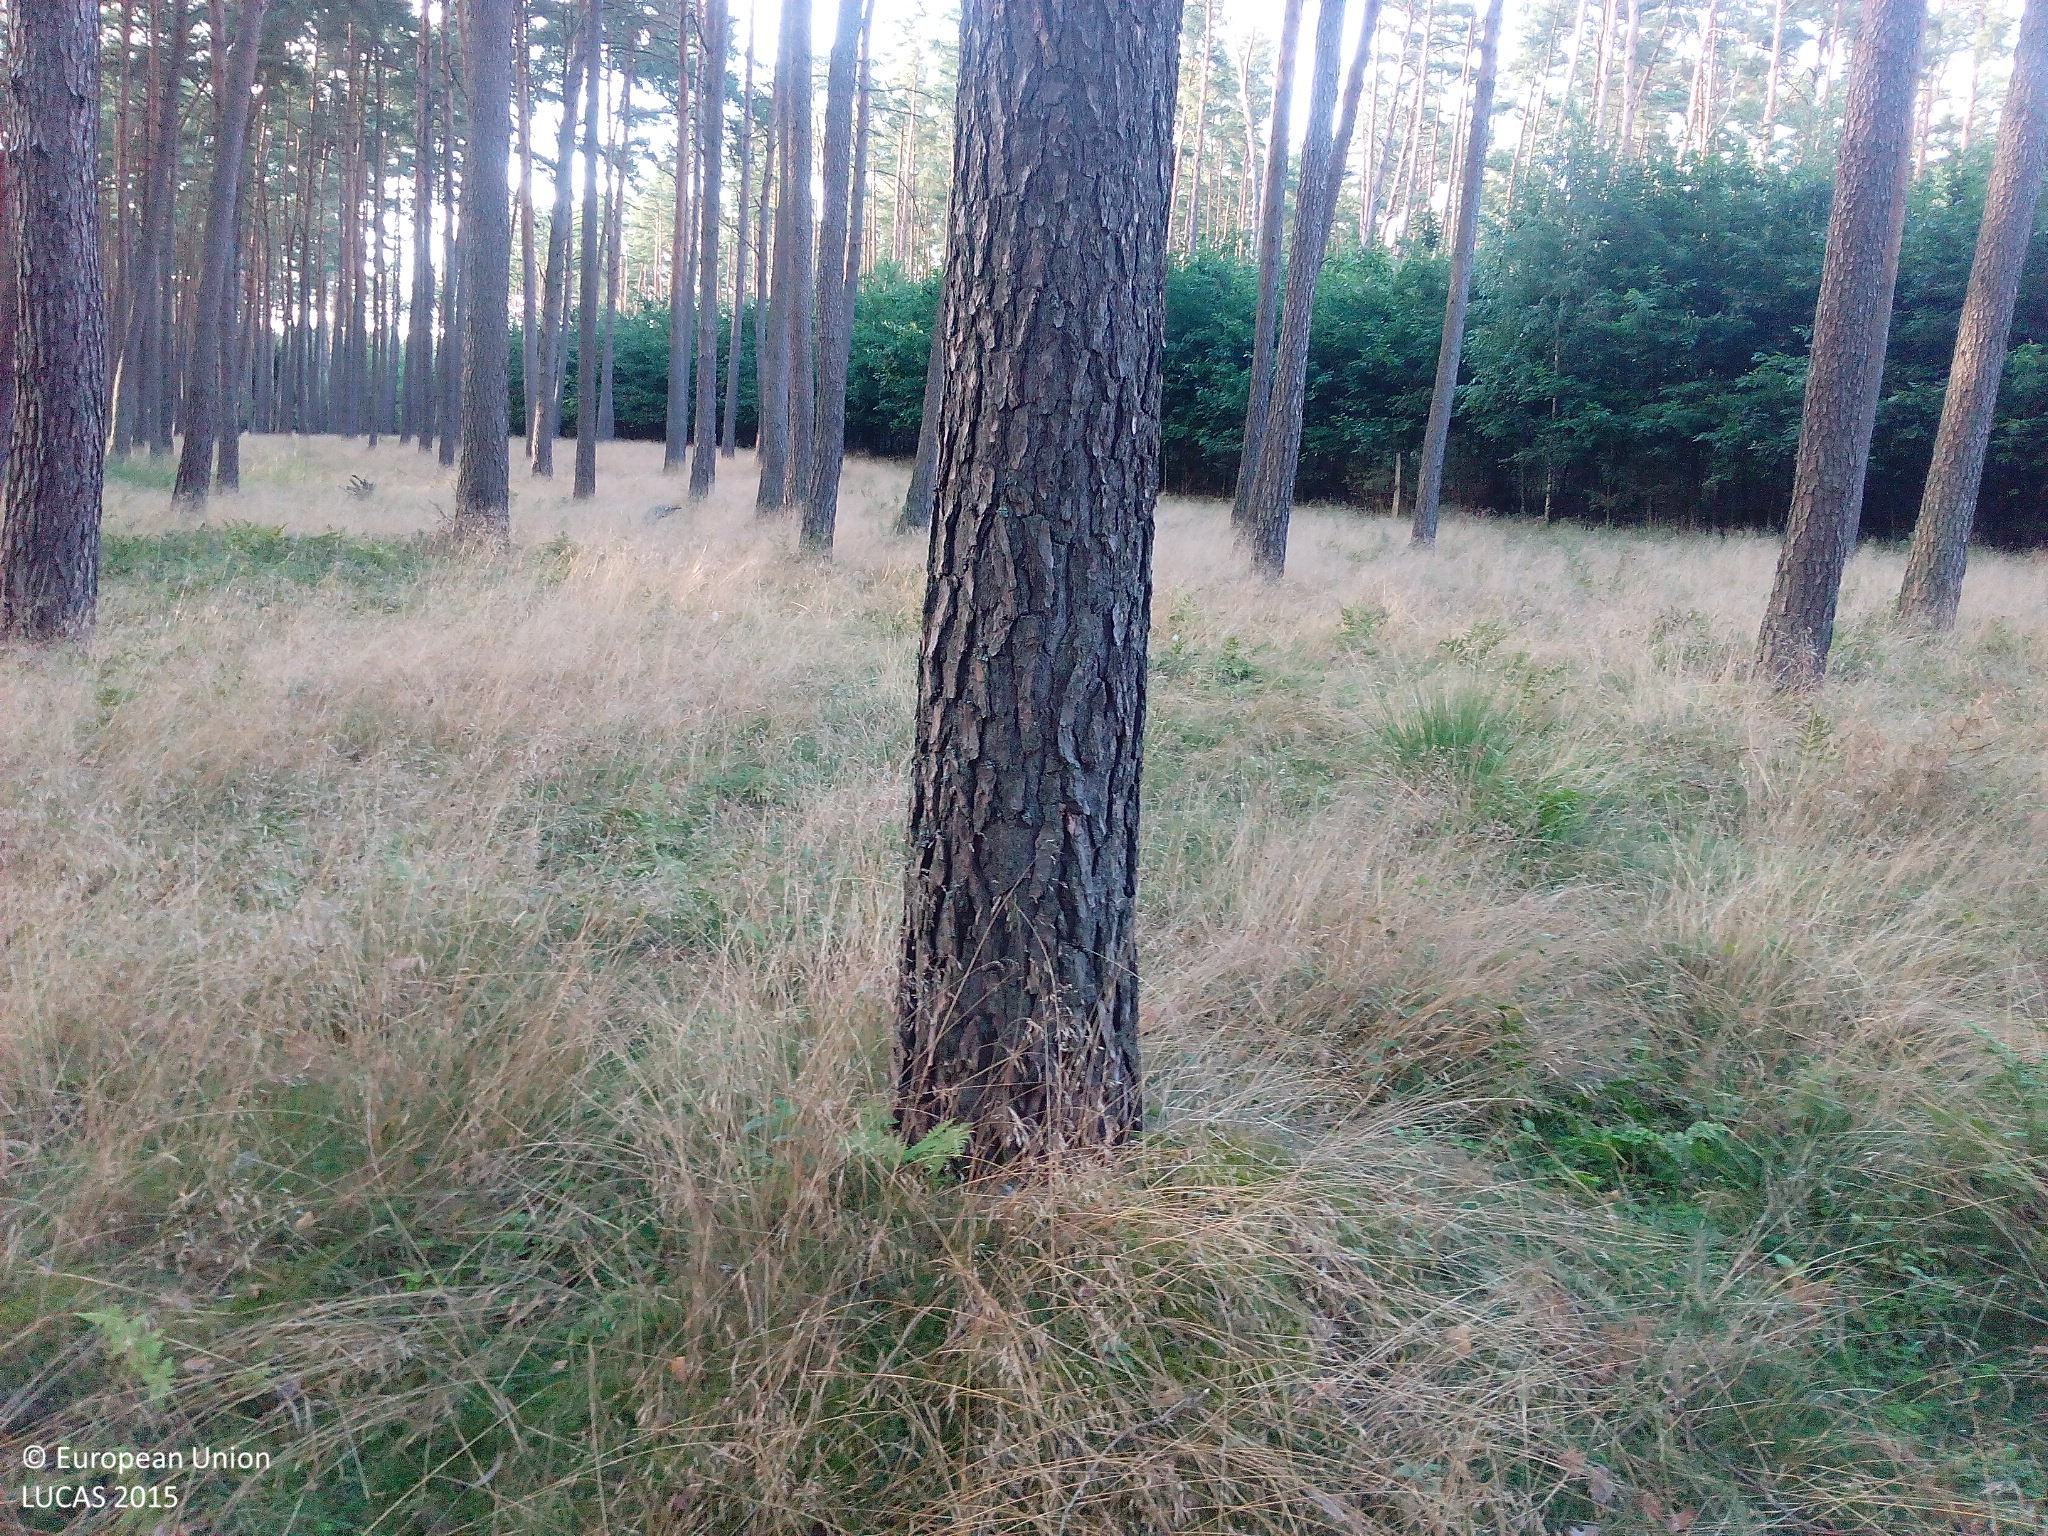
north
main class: Woodland
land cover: Pine dominated coniferous woodland
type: hemiboreal forest and nemoral coniferous forest and mixed broadleaved-coniferous forest
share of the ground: > 75 %
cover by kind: coniferous forest trees 75 %, herbaceous plants 25 %
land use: Forestry
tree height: > 5 m
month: August
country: DE
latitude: 53.5586
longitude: 12.3694
